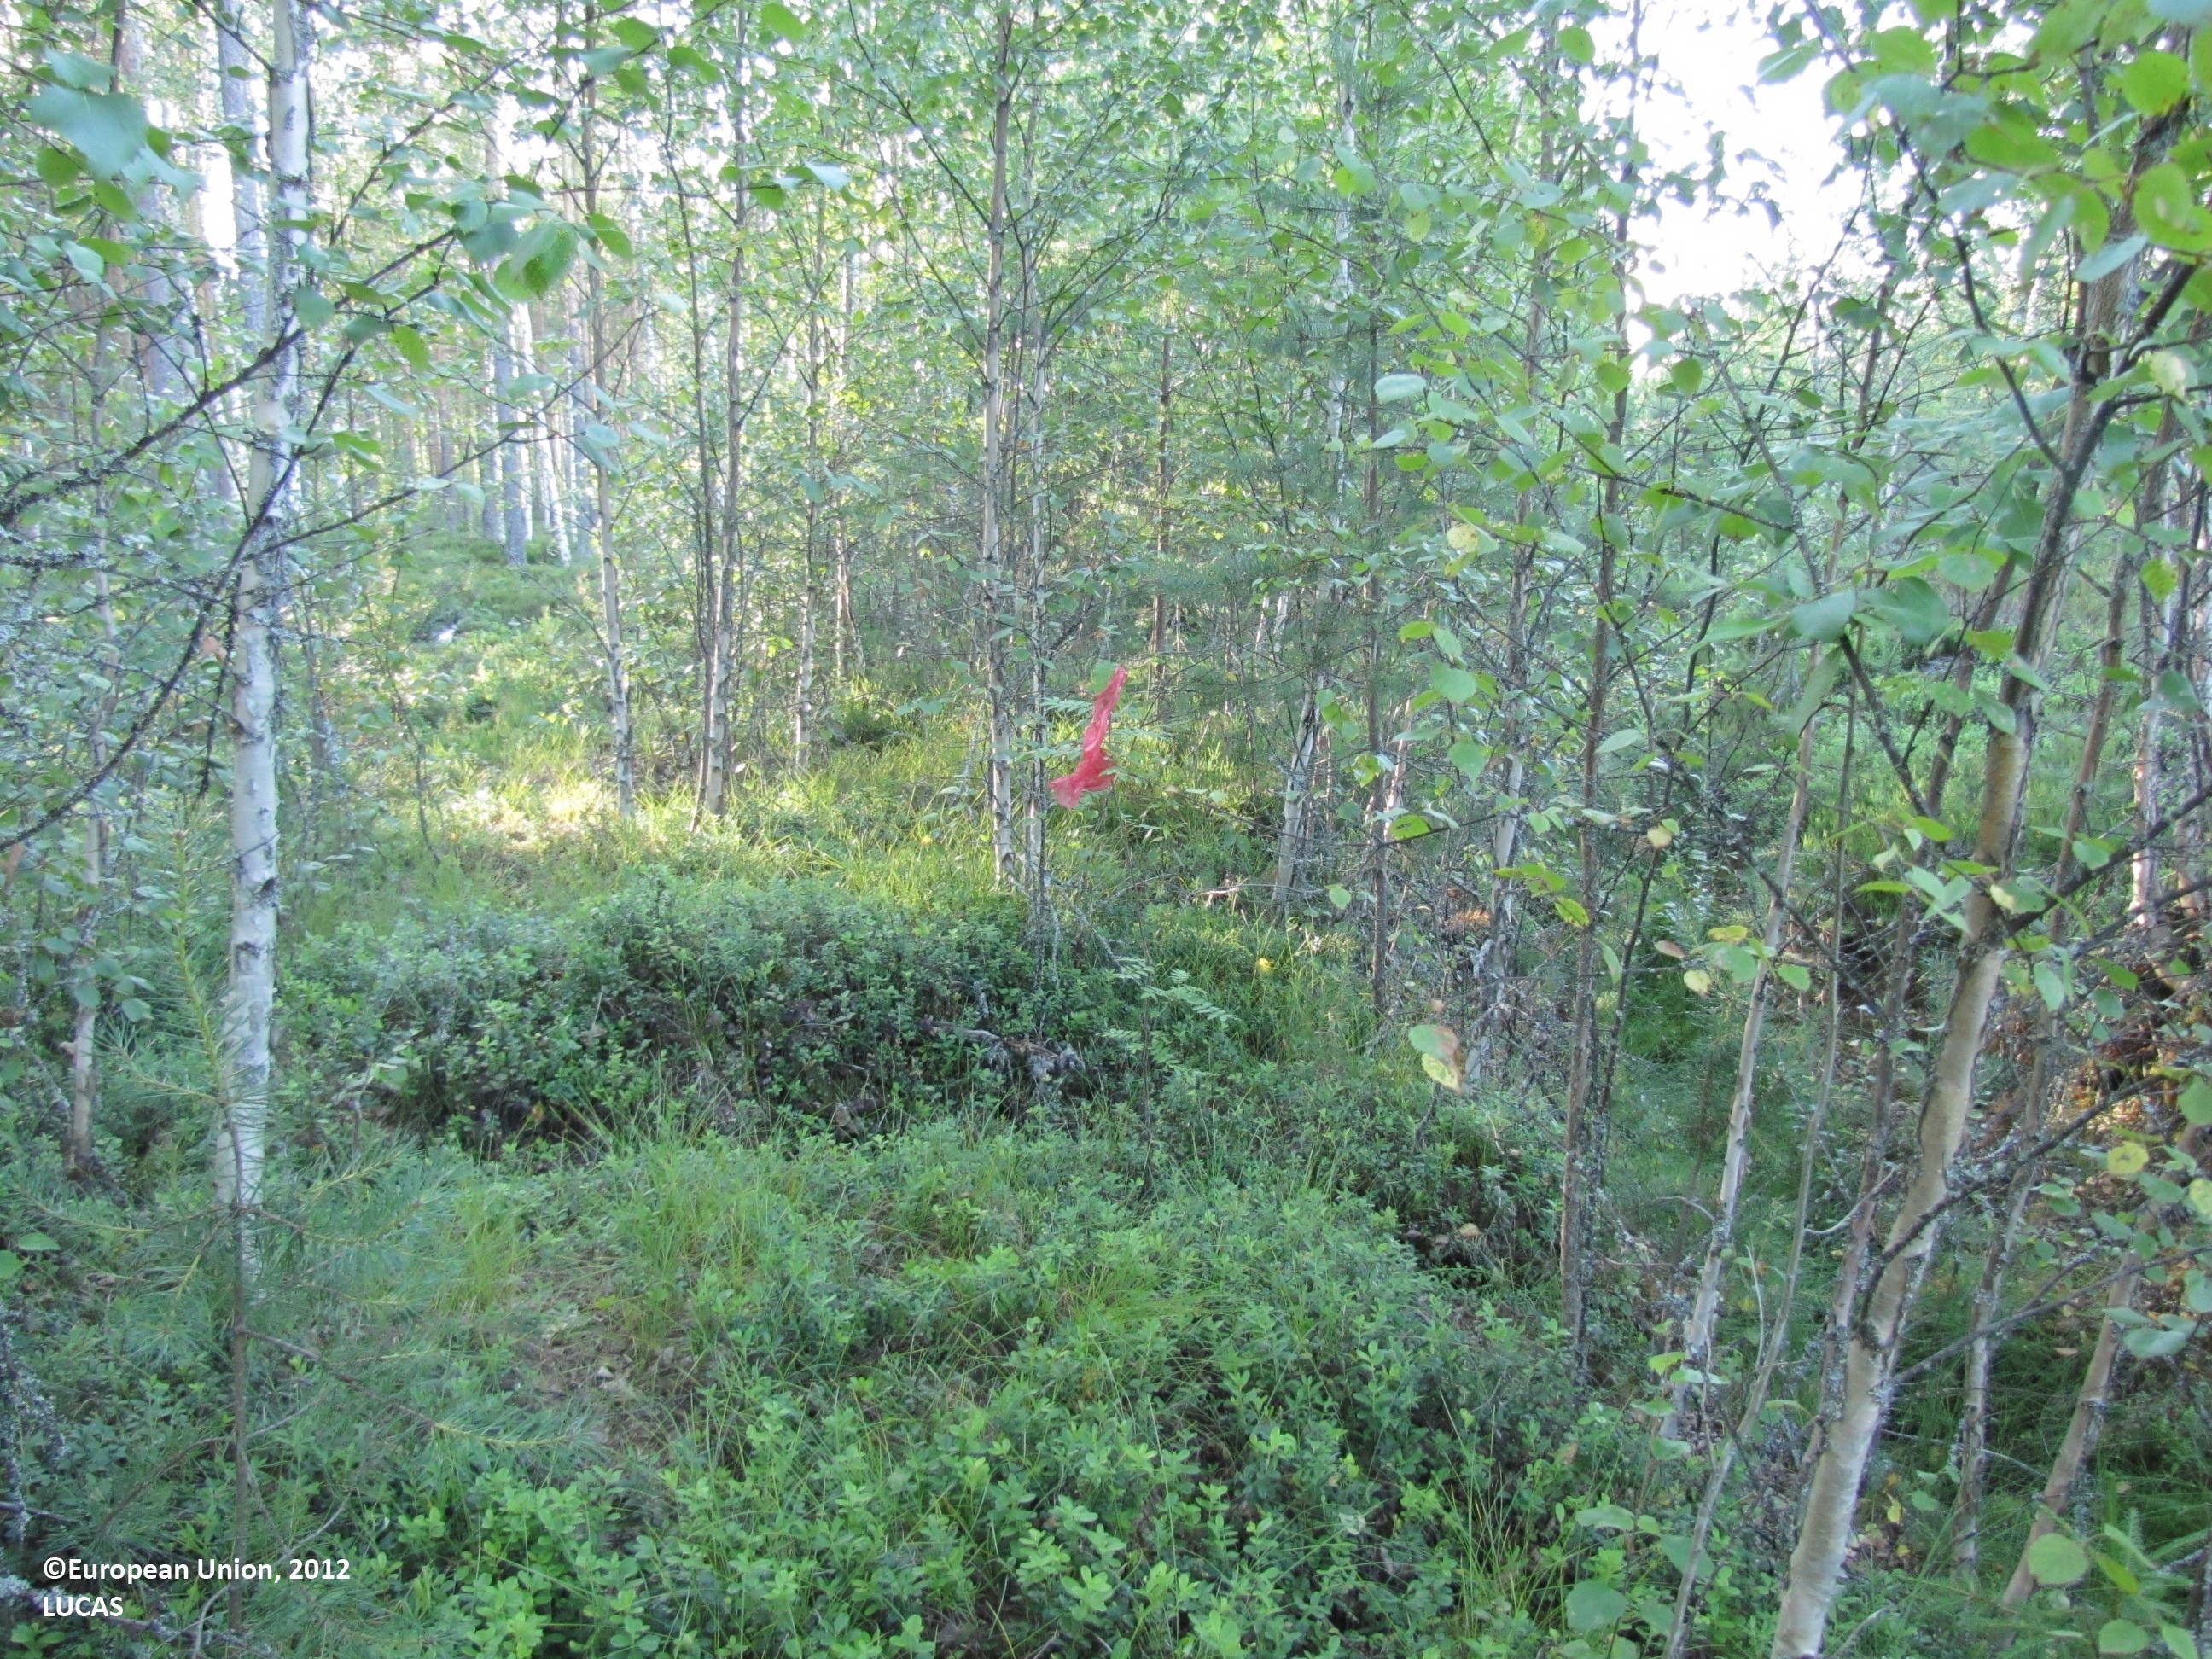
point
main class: Woodland
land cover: Broadleaved woodland
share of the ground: 25 - 50 %
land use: Forestry
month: July
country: FI
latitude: 62.5104
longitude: 23.1342
